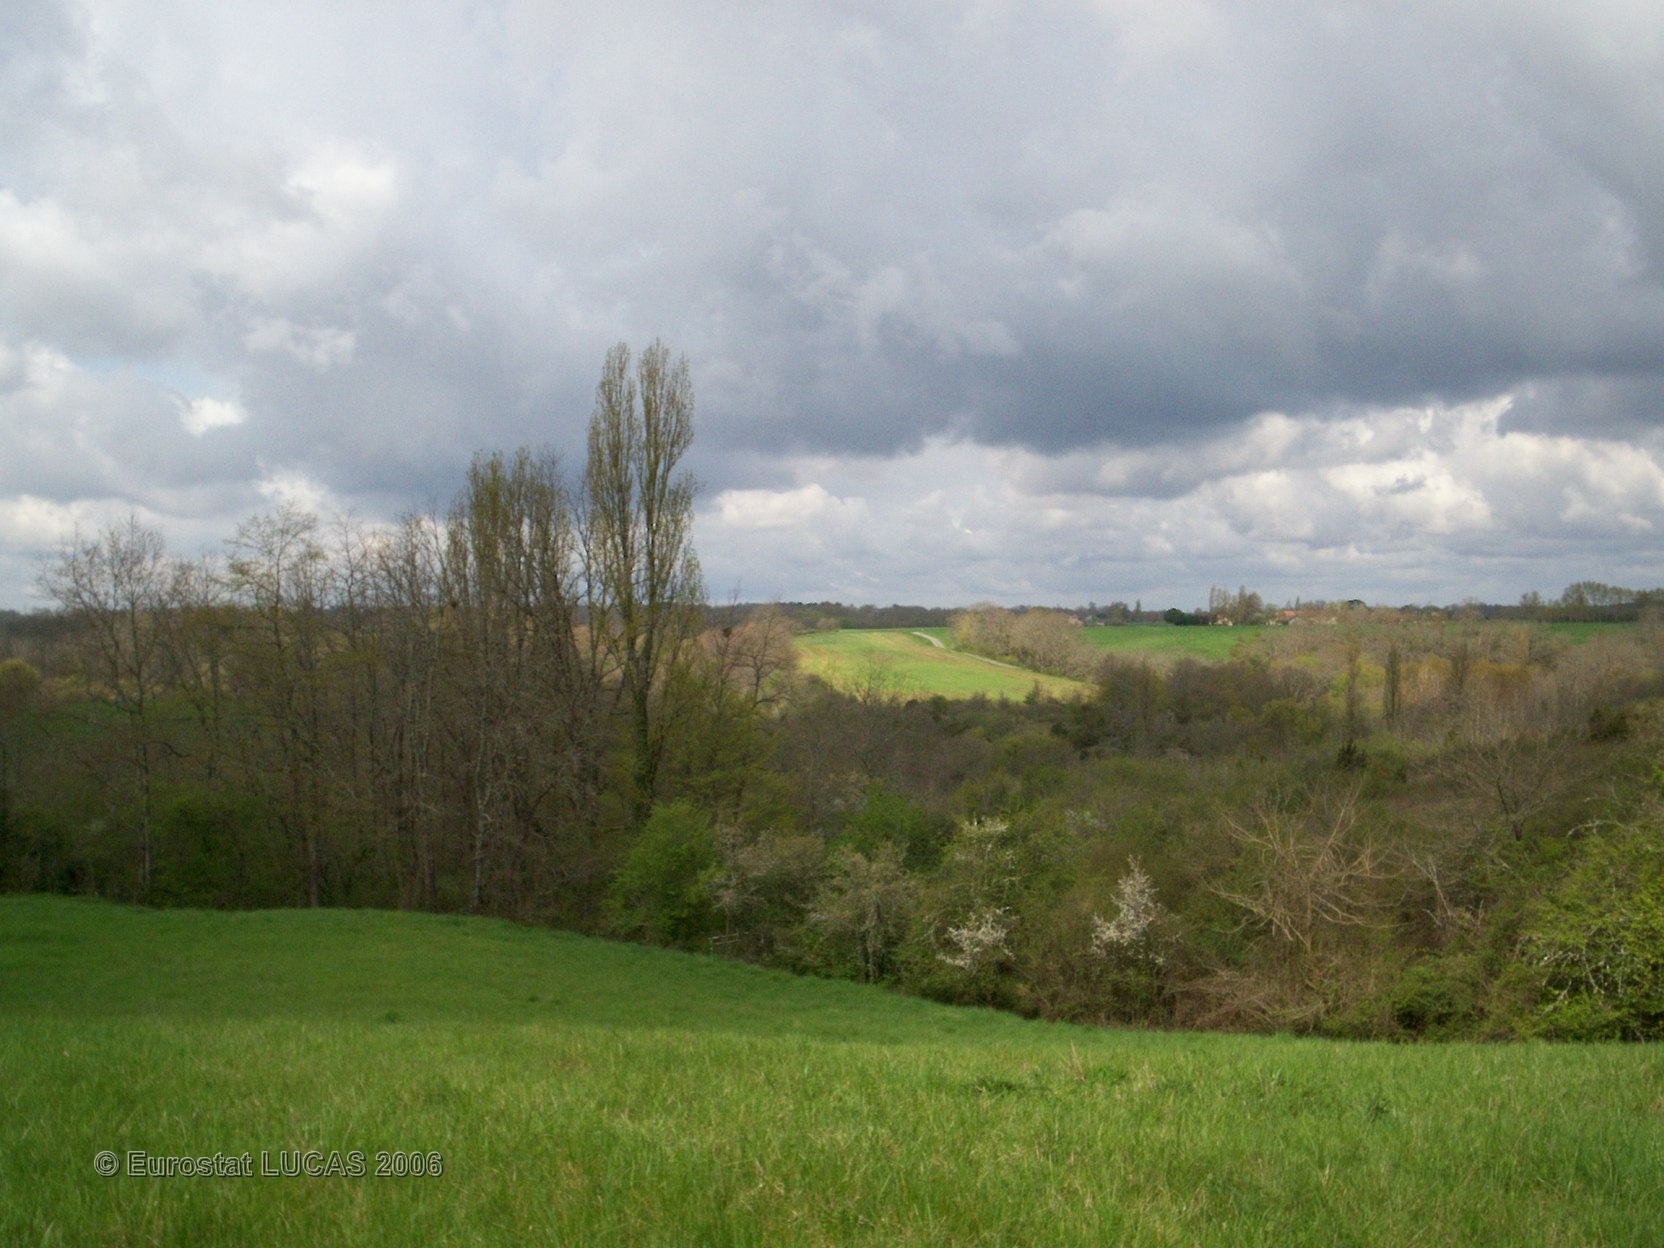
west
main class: Grassland
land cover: Grassland without tree/shrub cover
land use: Agriculture (excluding fallow land and kitchen gardens)
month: April
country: FR
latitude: 43.9701
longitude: 0.1332
